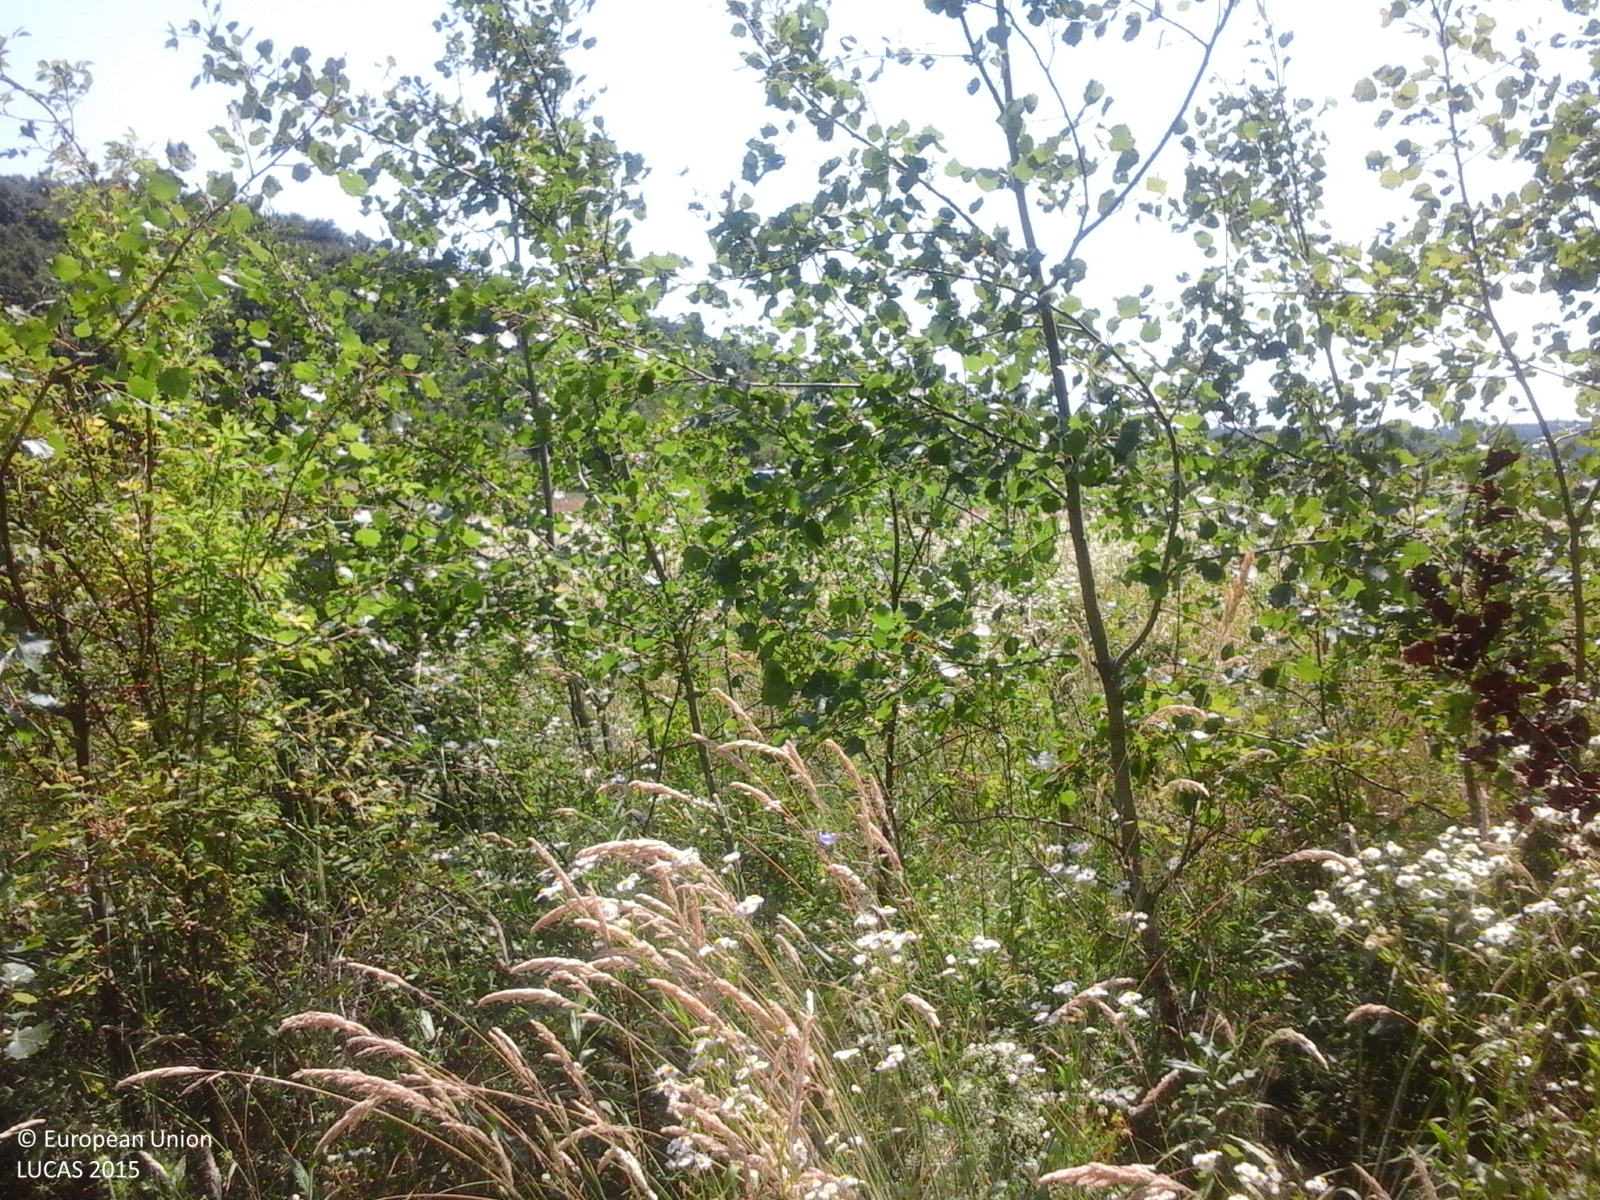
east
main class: Woodland
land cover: Broadleaved woodland
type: non-riverine alder, birch or aspen forest
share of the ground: > 75 %
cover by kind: broadleaved forest trees 100 %
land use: Forestry
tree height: > 5 m
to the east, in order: Broadleaved woodland; Spontaneously vegetated surfaces; Shrubland with sparse tree cover; Spontaneously vegetated surfaces; Maize; Artificial constructions in urban areas; Broadleaved woodland
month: July
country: RO
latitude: 44.8045
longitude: 24.5251
